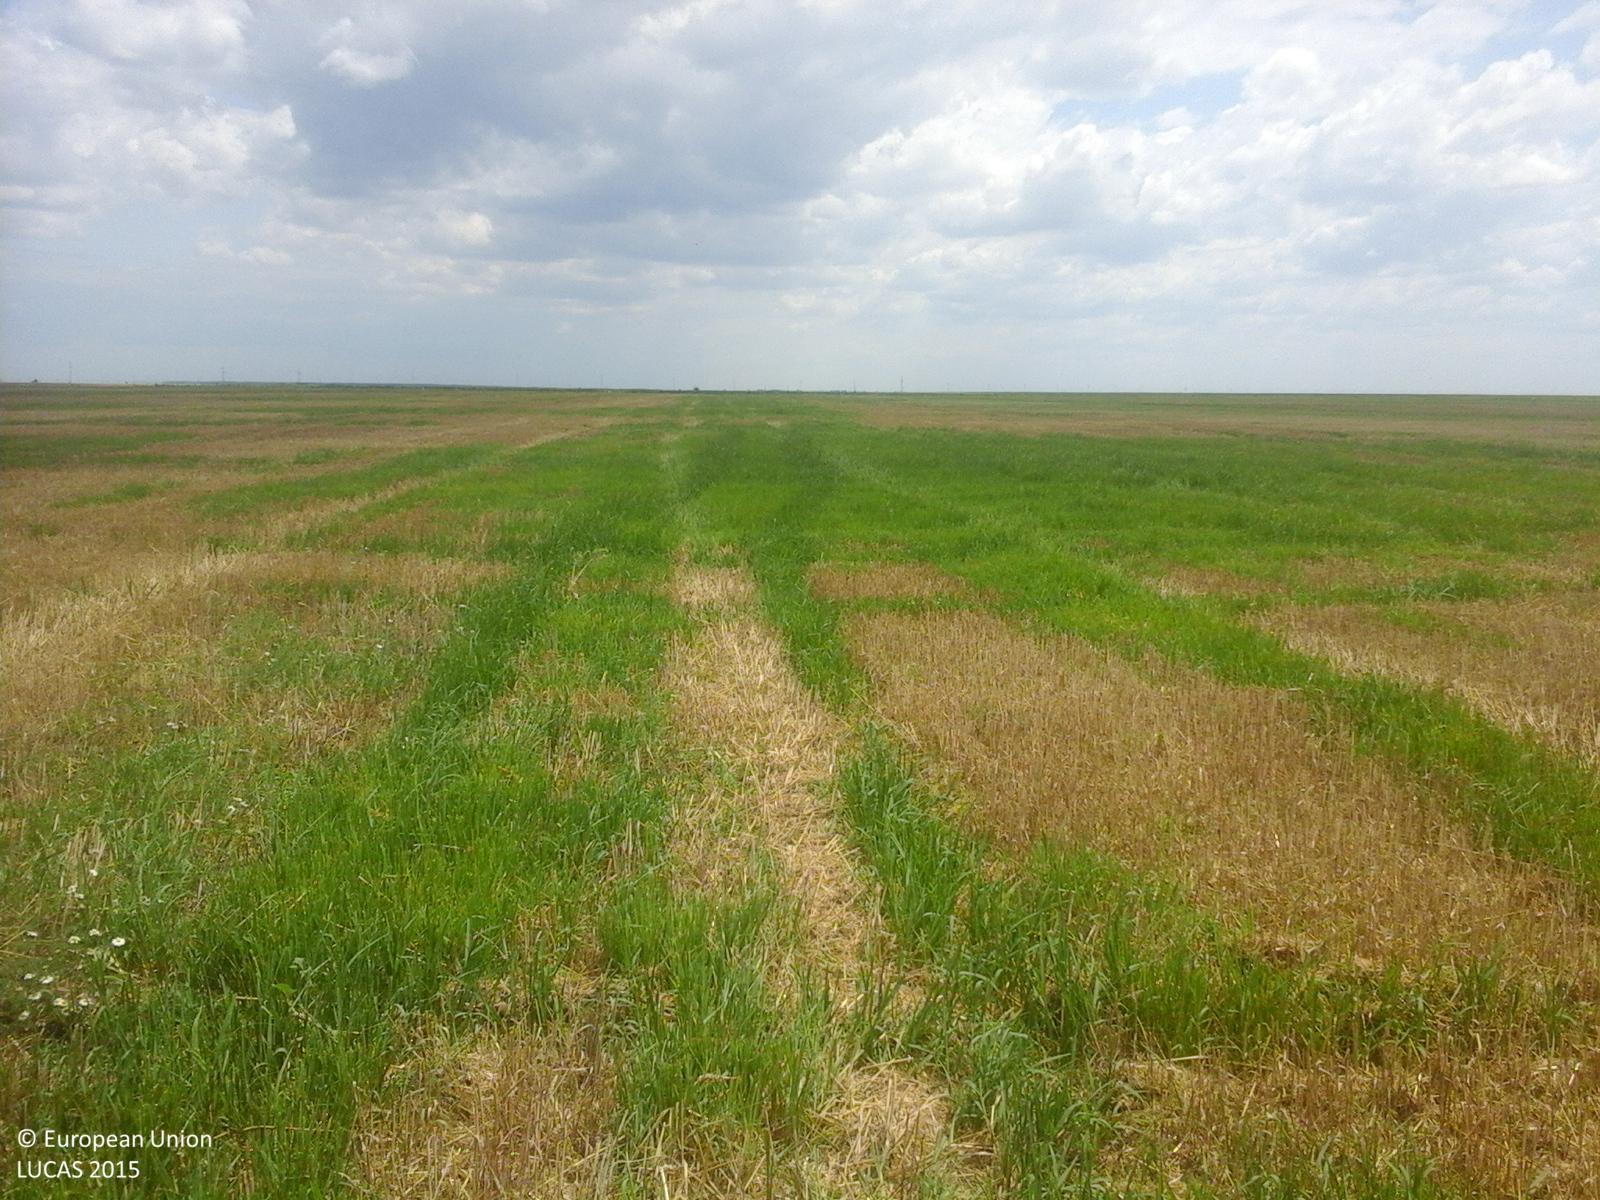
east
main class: Cropland
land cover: Common wheat
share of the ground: < 10 %
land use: Agriculture (excluding fallow land and kitchen gardens)
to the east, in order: Common wheat
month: July
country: RO
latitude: 44.3422
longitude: 24.9421
